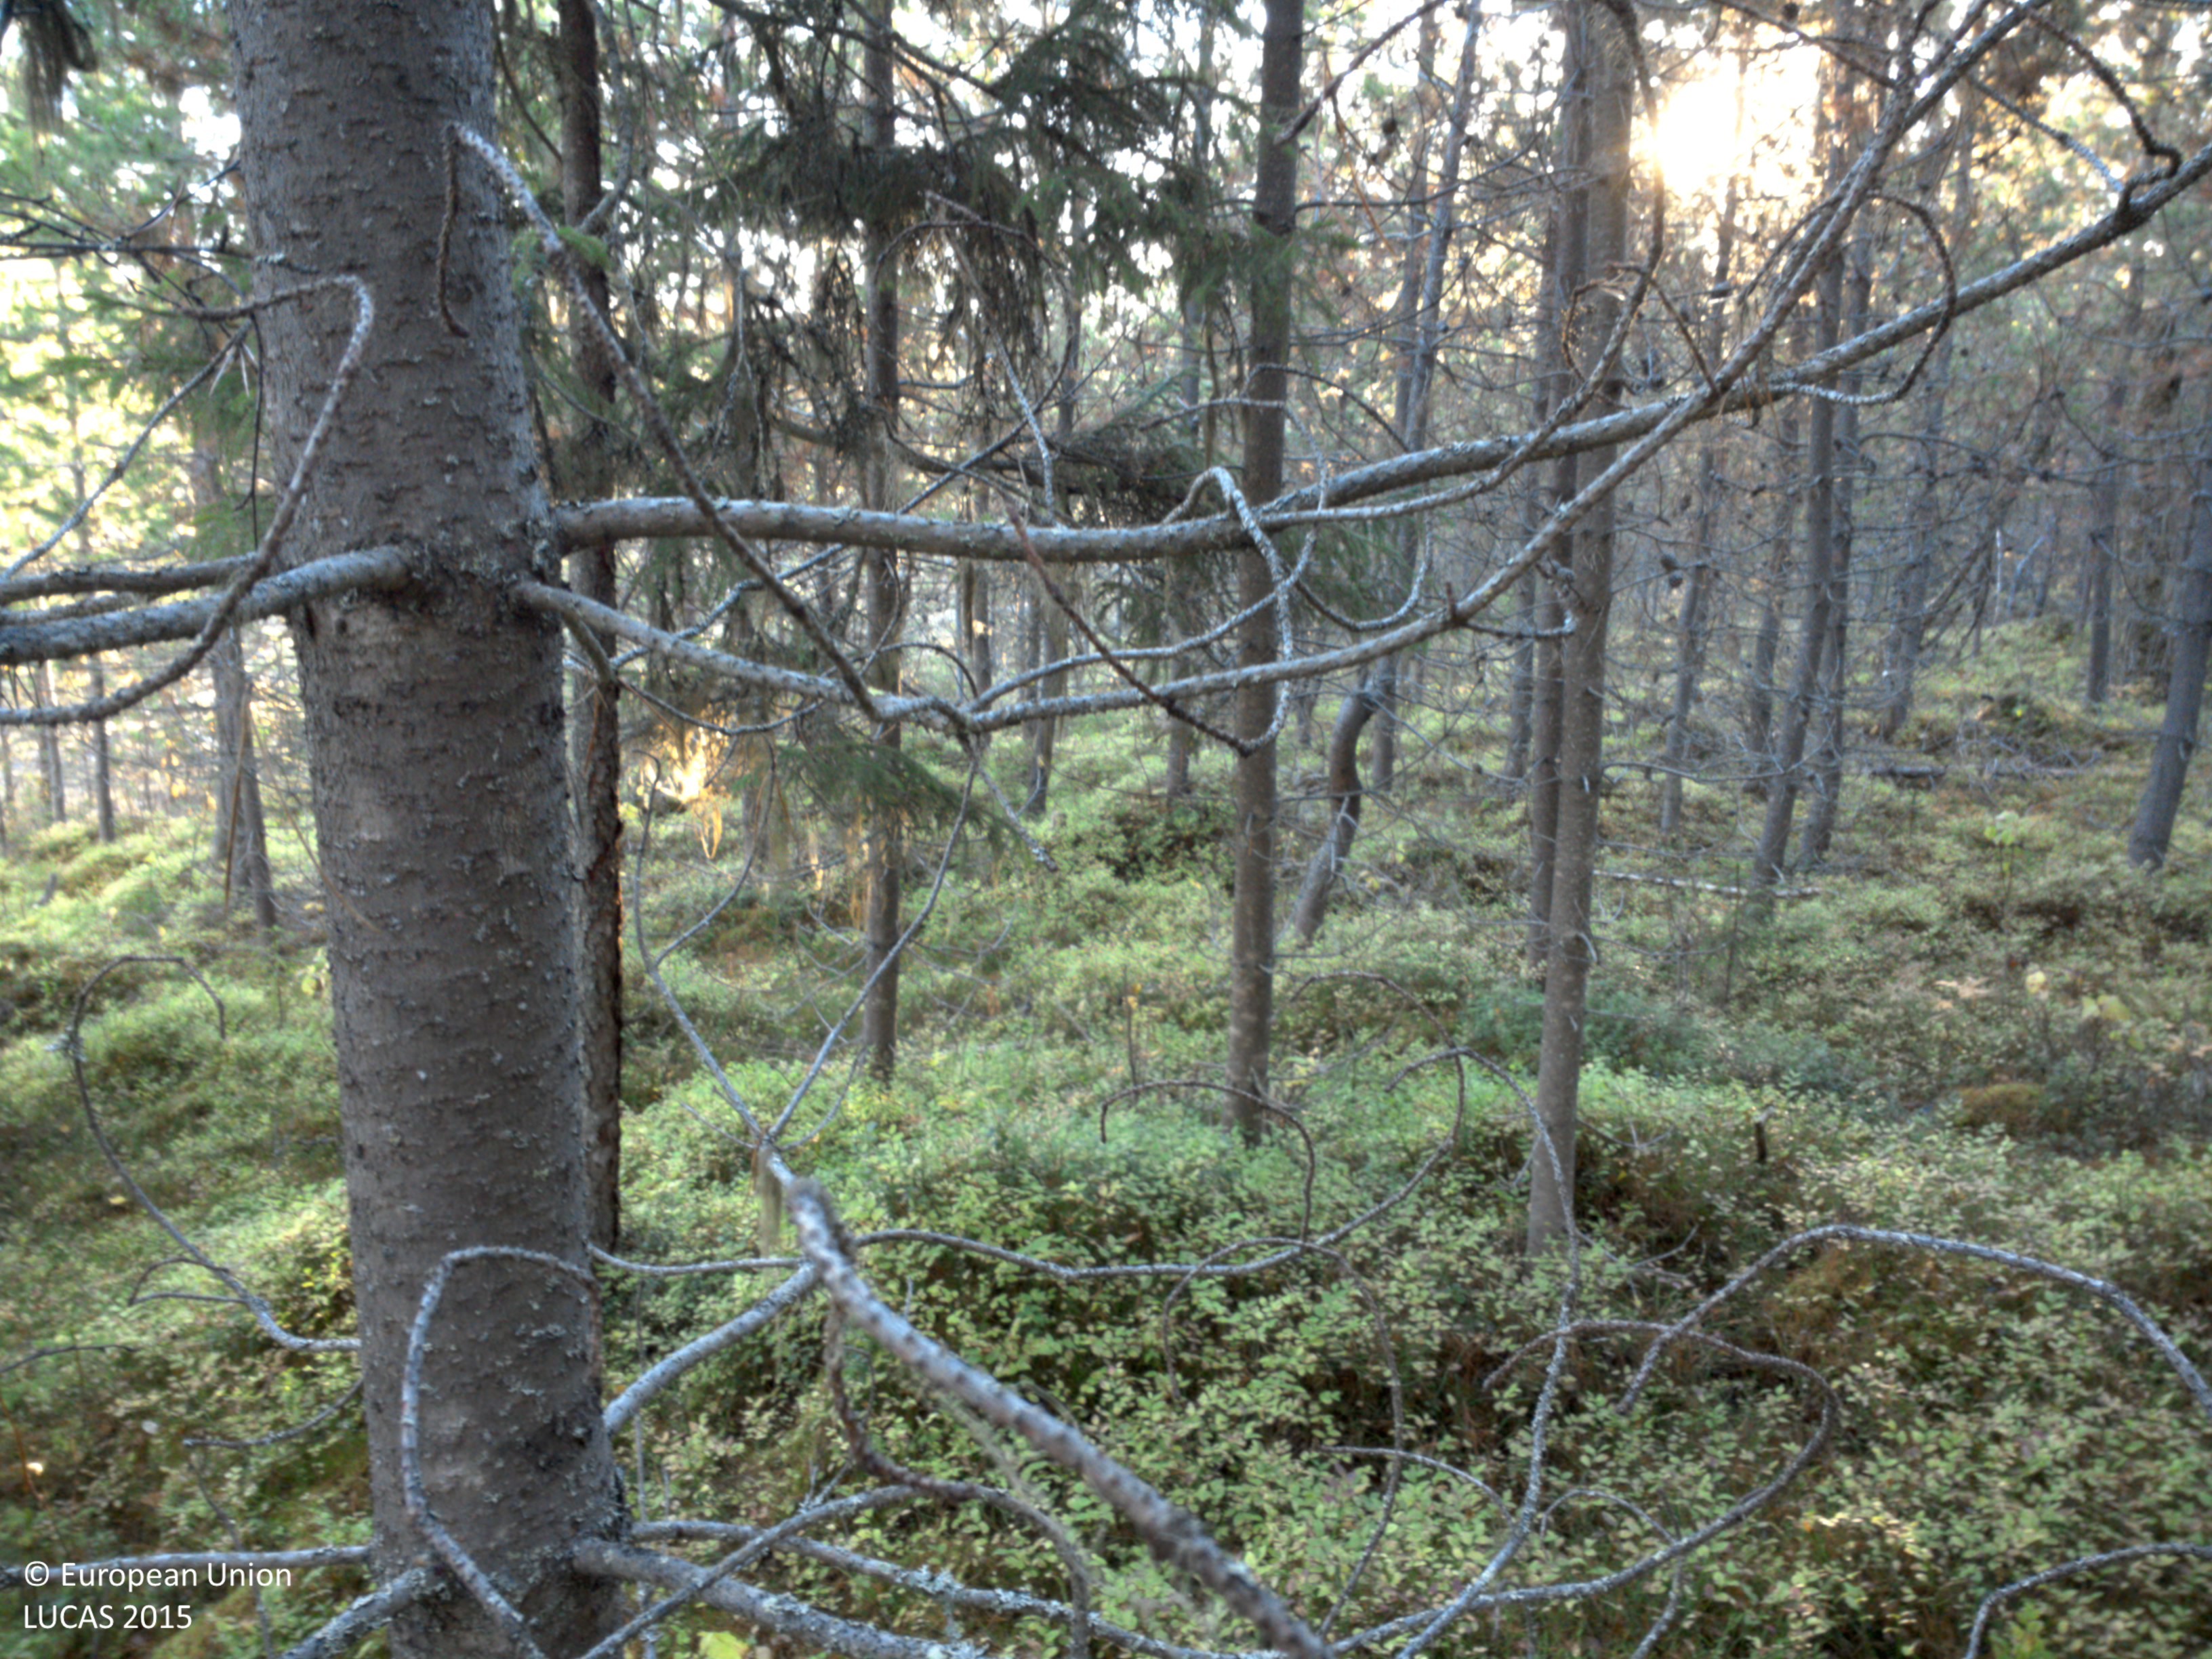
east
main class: Woodland
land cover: Pine dominated coniferous woodland
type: exotic forest
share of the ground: 50 - 75 %
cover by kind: coniferous forest trees 60 %, shrubs 25 %, lichens and mosses 10 %, broadleaved forest trees 5 %
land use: Forestry
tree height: > 5 m
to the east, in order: Pine dominated coniferous woodland; Shrubland with sparse tree cover; Spruce dominated mixed woodland; Shrubland with sparse tree cover; Spruce dominated mixed woodland; Ponds and wetlands; Pine dominated coniferous woodland
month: October
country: SE
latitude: 64.8585
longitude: 17.8332
